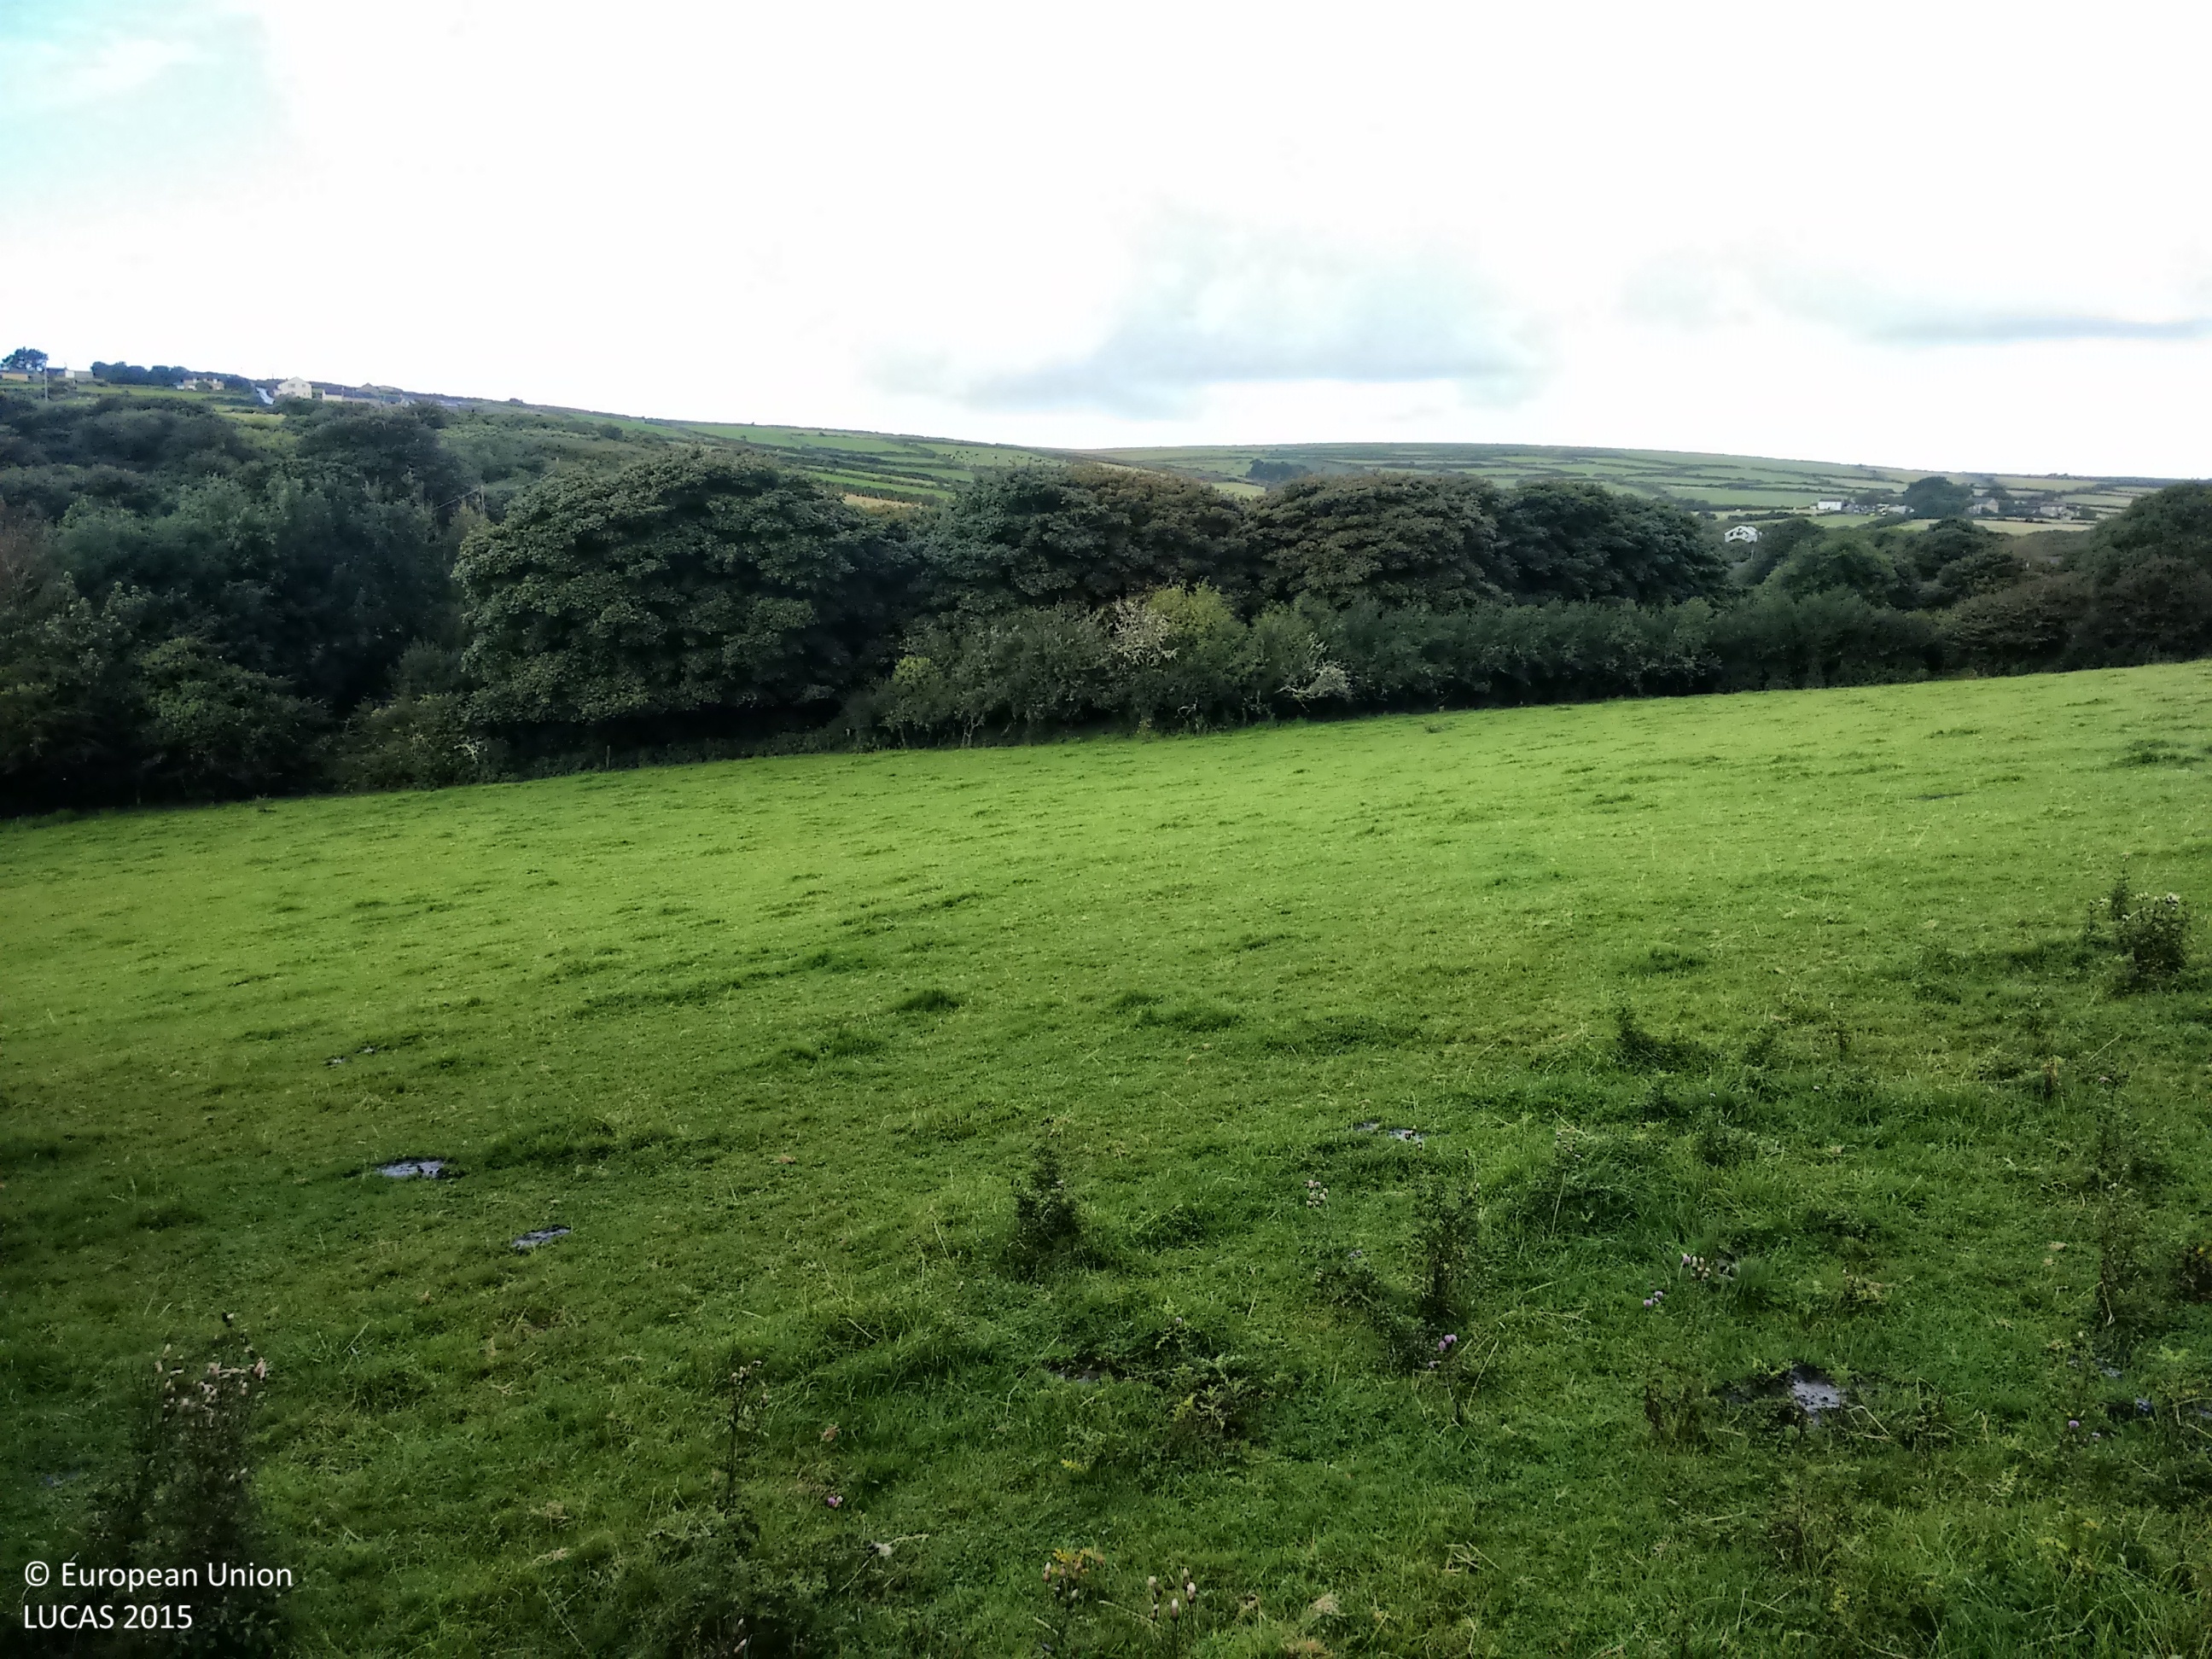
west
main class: Grassland
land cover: Grassland without tree/shrub cover
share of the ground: > 75 %
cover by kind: herbaceous plants 100 %
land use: Agriculture (excluding fallow land and kitchen gardens)
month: August
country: GB
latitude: 50.1757
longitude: -5.5167
